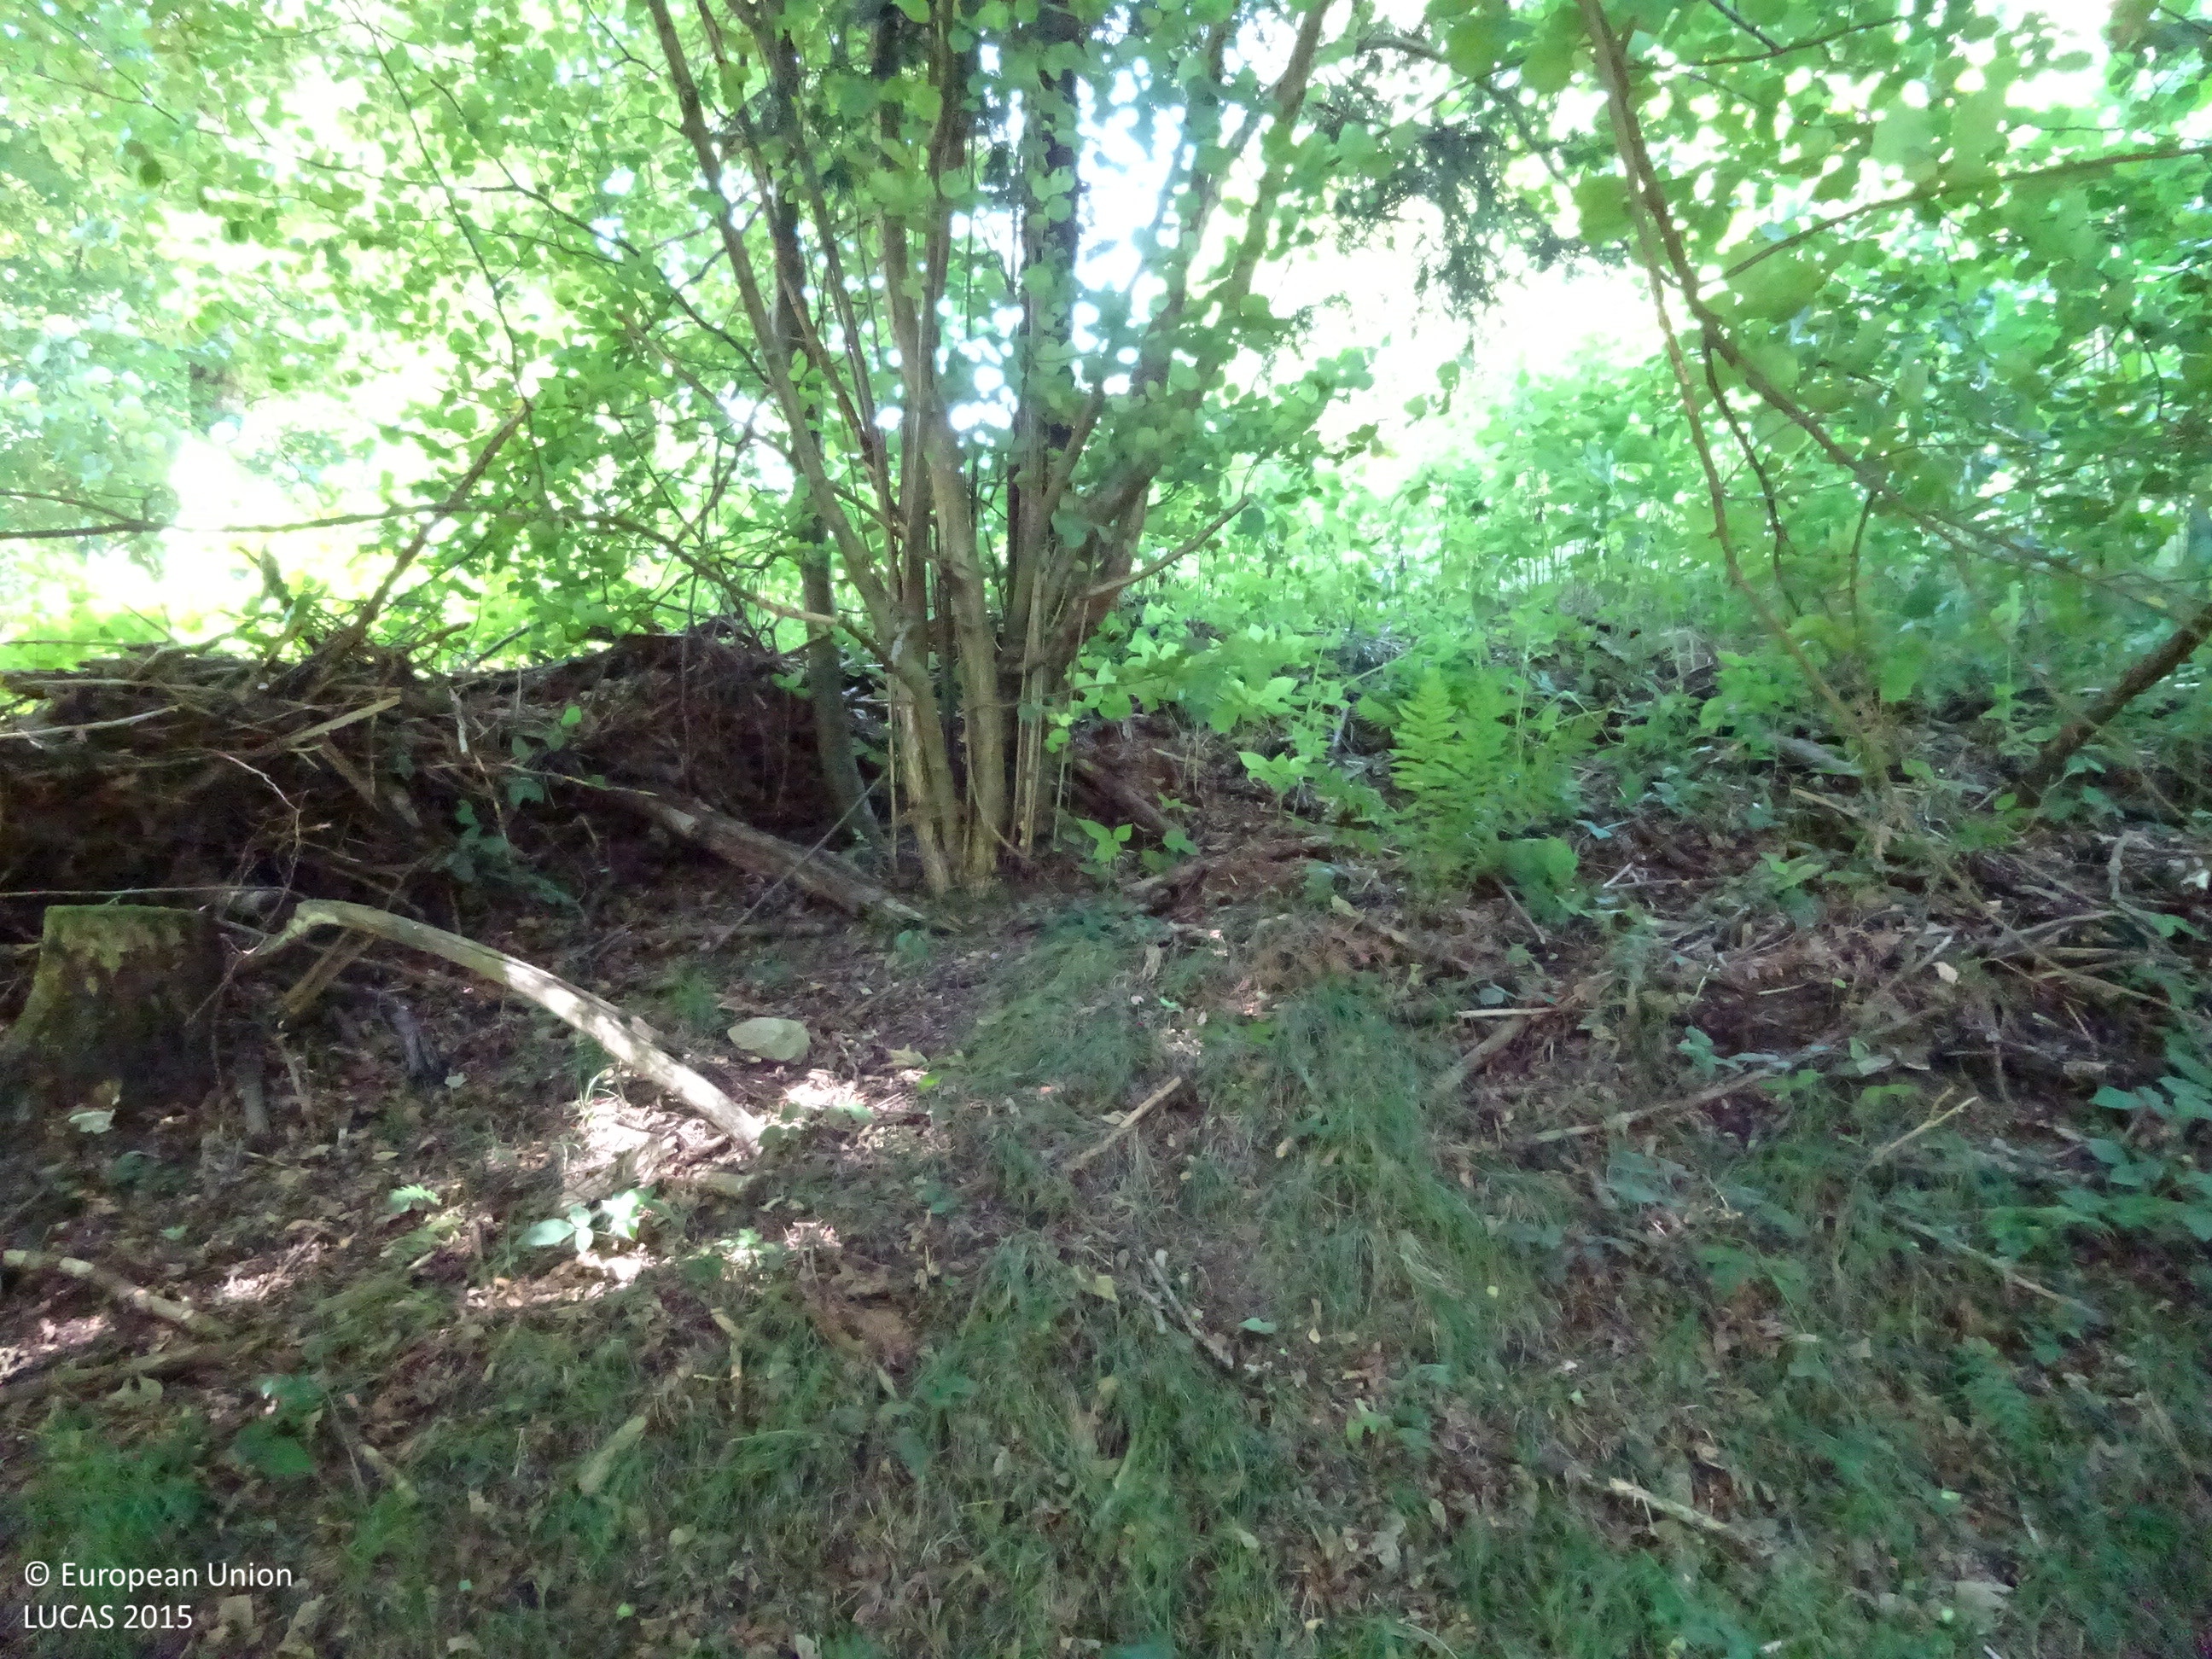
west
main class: Woodland
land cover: Other mixed woodland
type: alpine coniferous forest
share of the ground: > 75 %
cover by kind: shrubs 45 %, coniferous forest trees 30 %, broadleaved forest trees 25 %
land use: Forestry
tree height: > 5 m
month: August
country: AT
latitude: 47.4954
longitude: 16.0953
